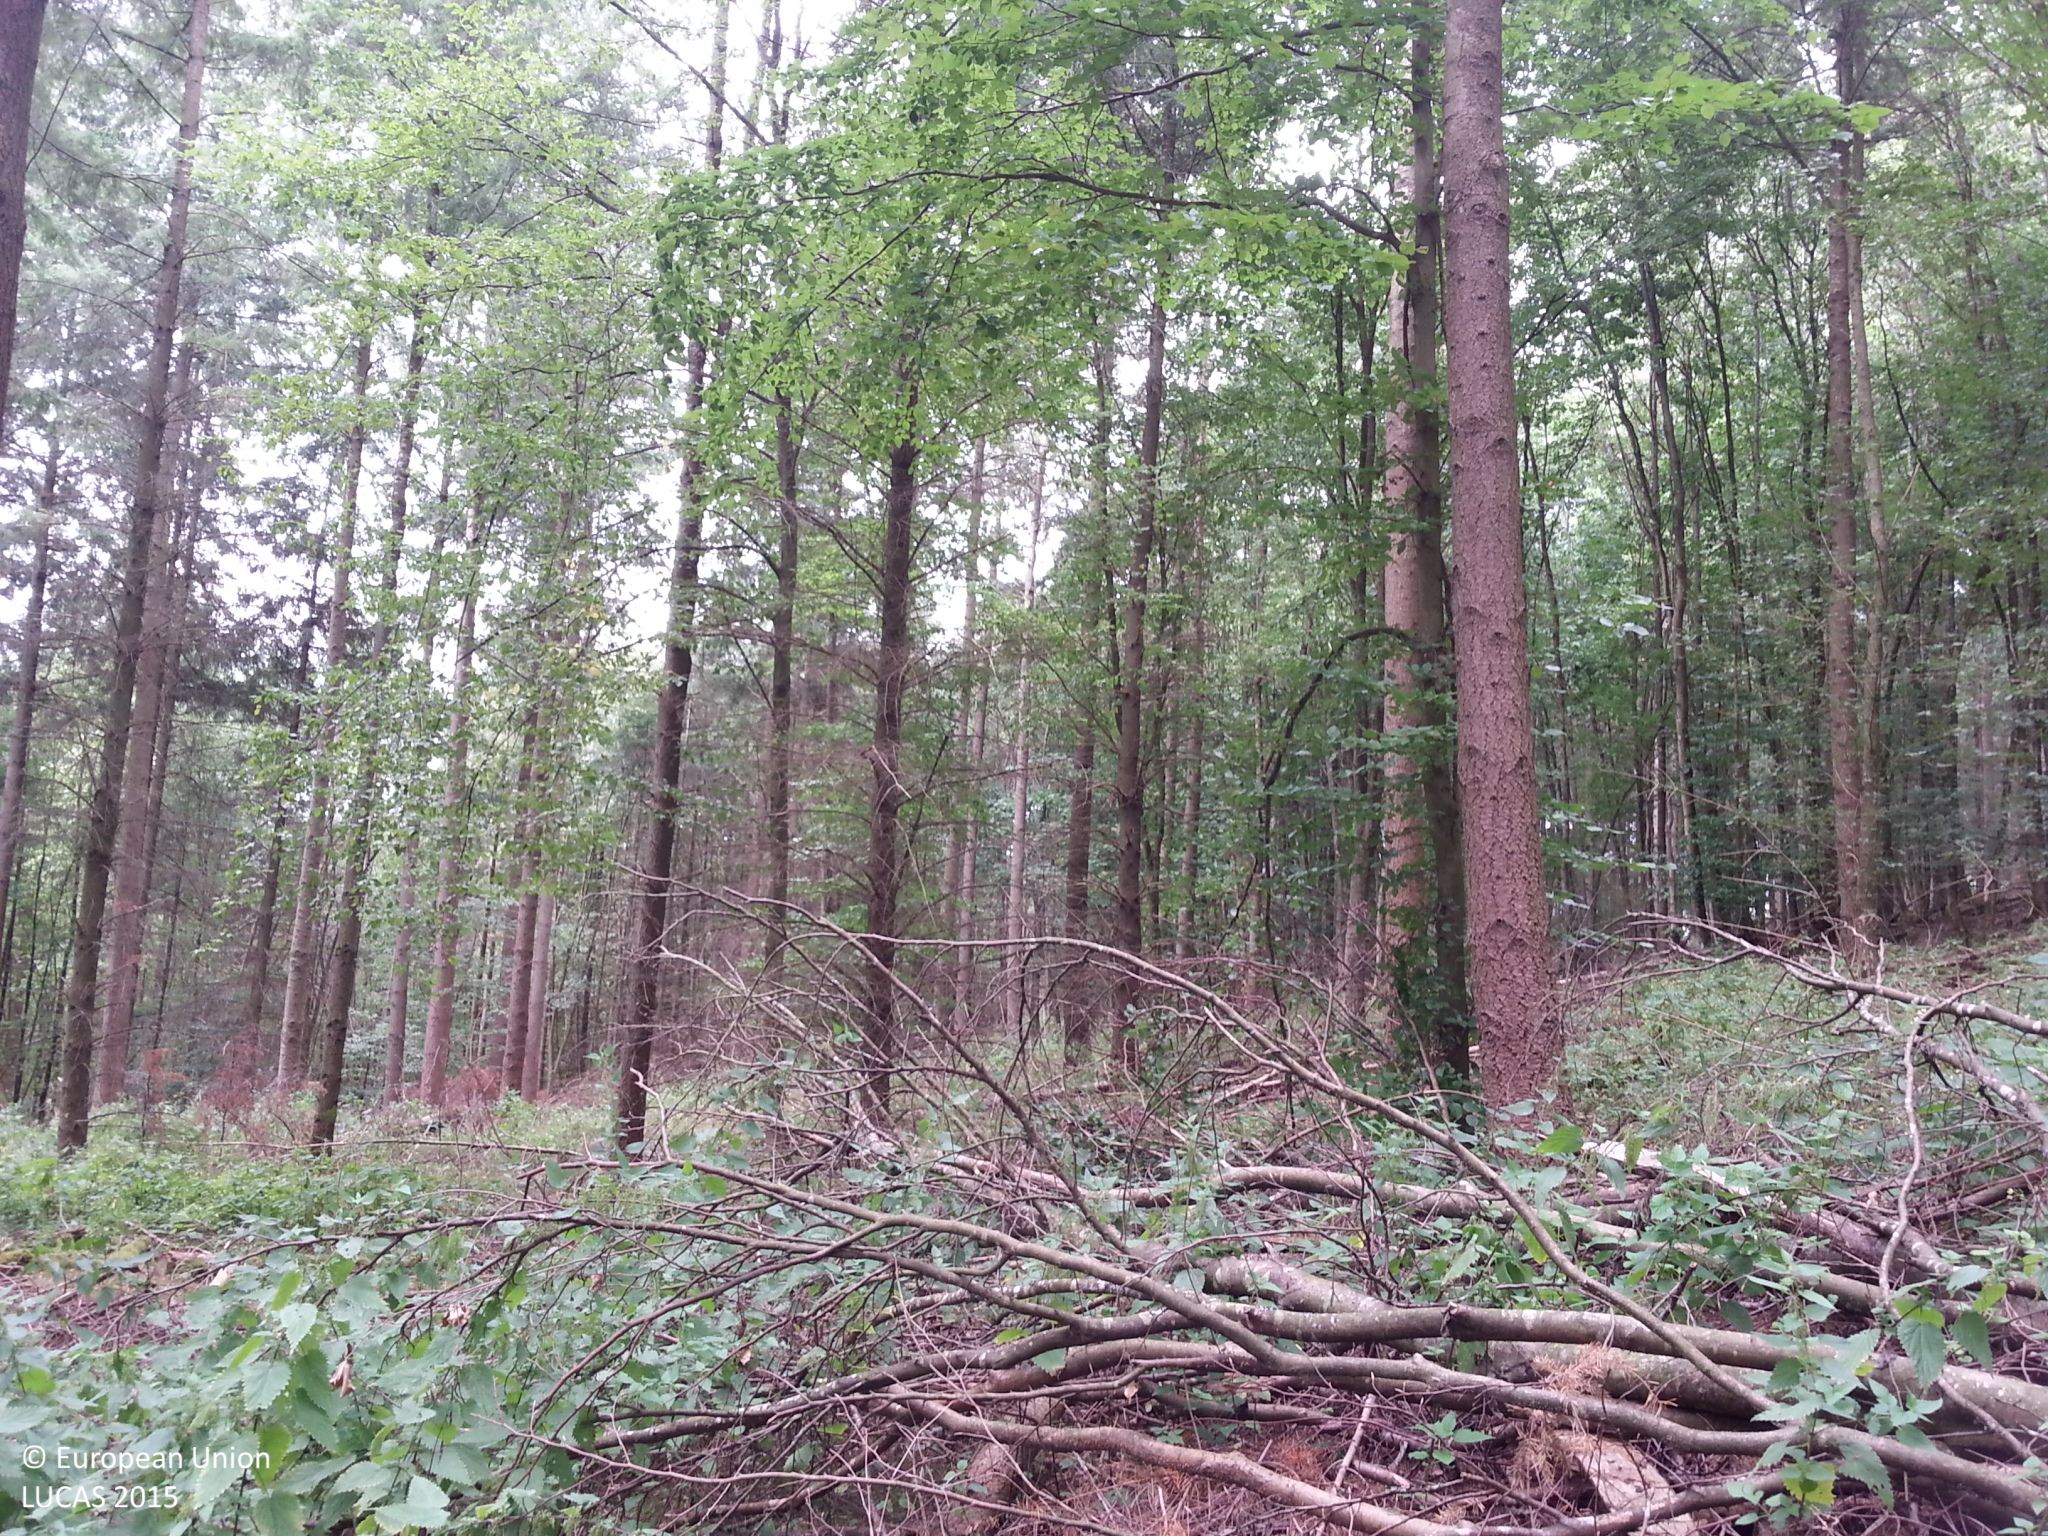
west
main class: Woodland
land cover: Spruce dominated coniferous woodland
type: boreal forest
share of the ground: > 75 %
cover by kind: coniferous forest trees 65 %, broadleaved forest trees 15 %, lichens and mosses 10 %, herbaceous plants 5 %, unconsolidated bare surface 5 %
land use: Forestry
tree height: > 5 m
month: September
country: DE
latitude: 49.4453
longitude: 9.4071
